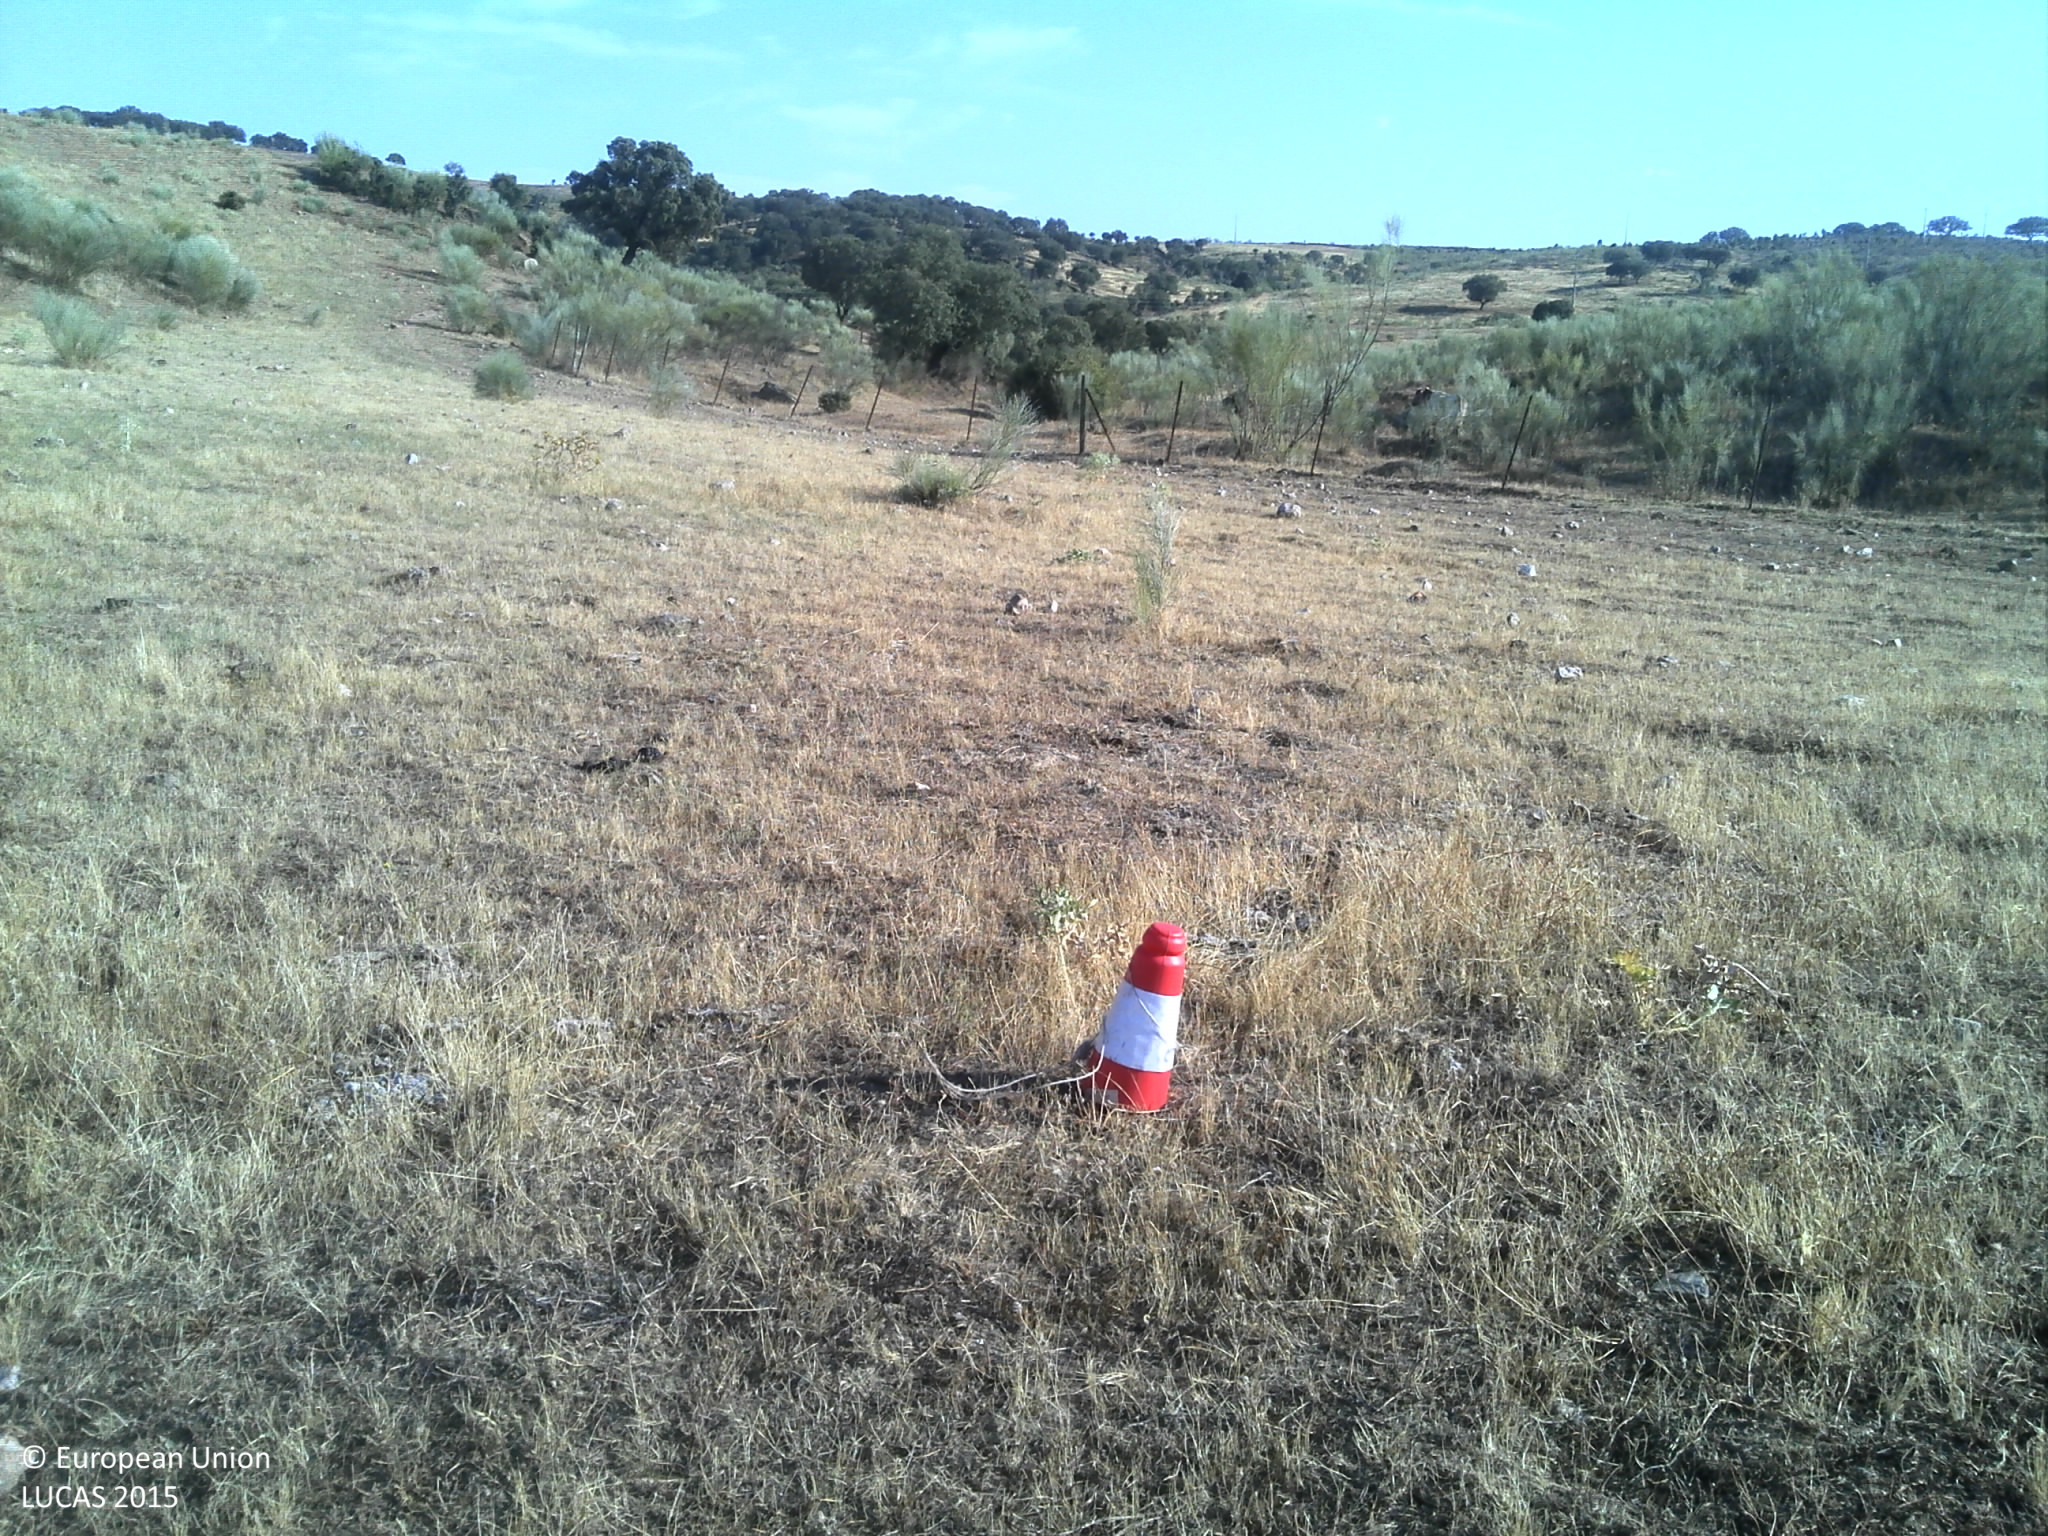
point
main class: Grassland
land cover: Grassland without tree/shrub cover
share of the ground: 10 - 25 %
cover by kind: unconsolidated bare surface 65 %, herbaceous plants 25 %, shrubs 5 %
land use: Agriculture (excluding fallow land and kitchen gardens)
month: June
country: PT
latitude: 39.8237
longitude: -6.9930
